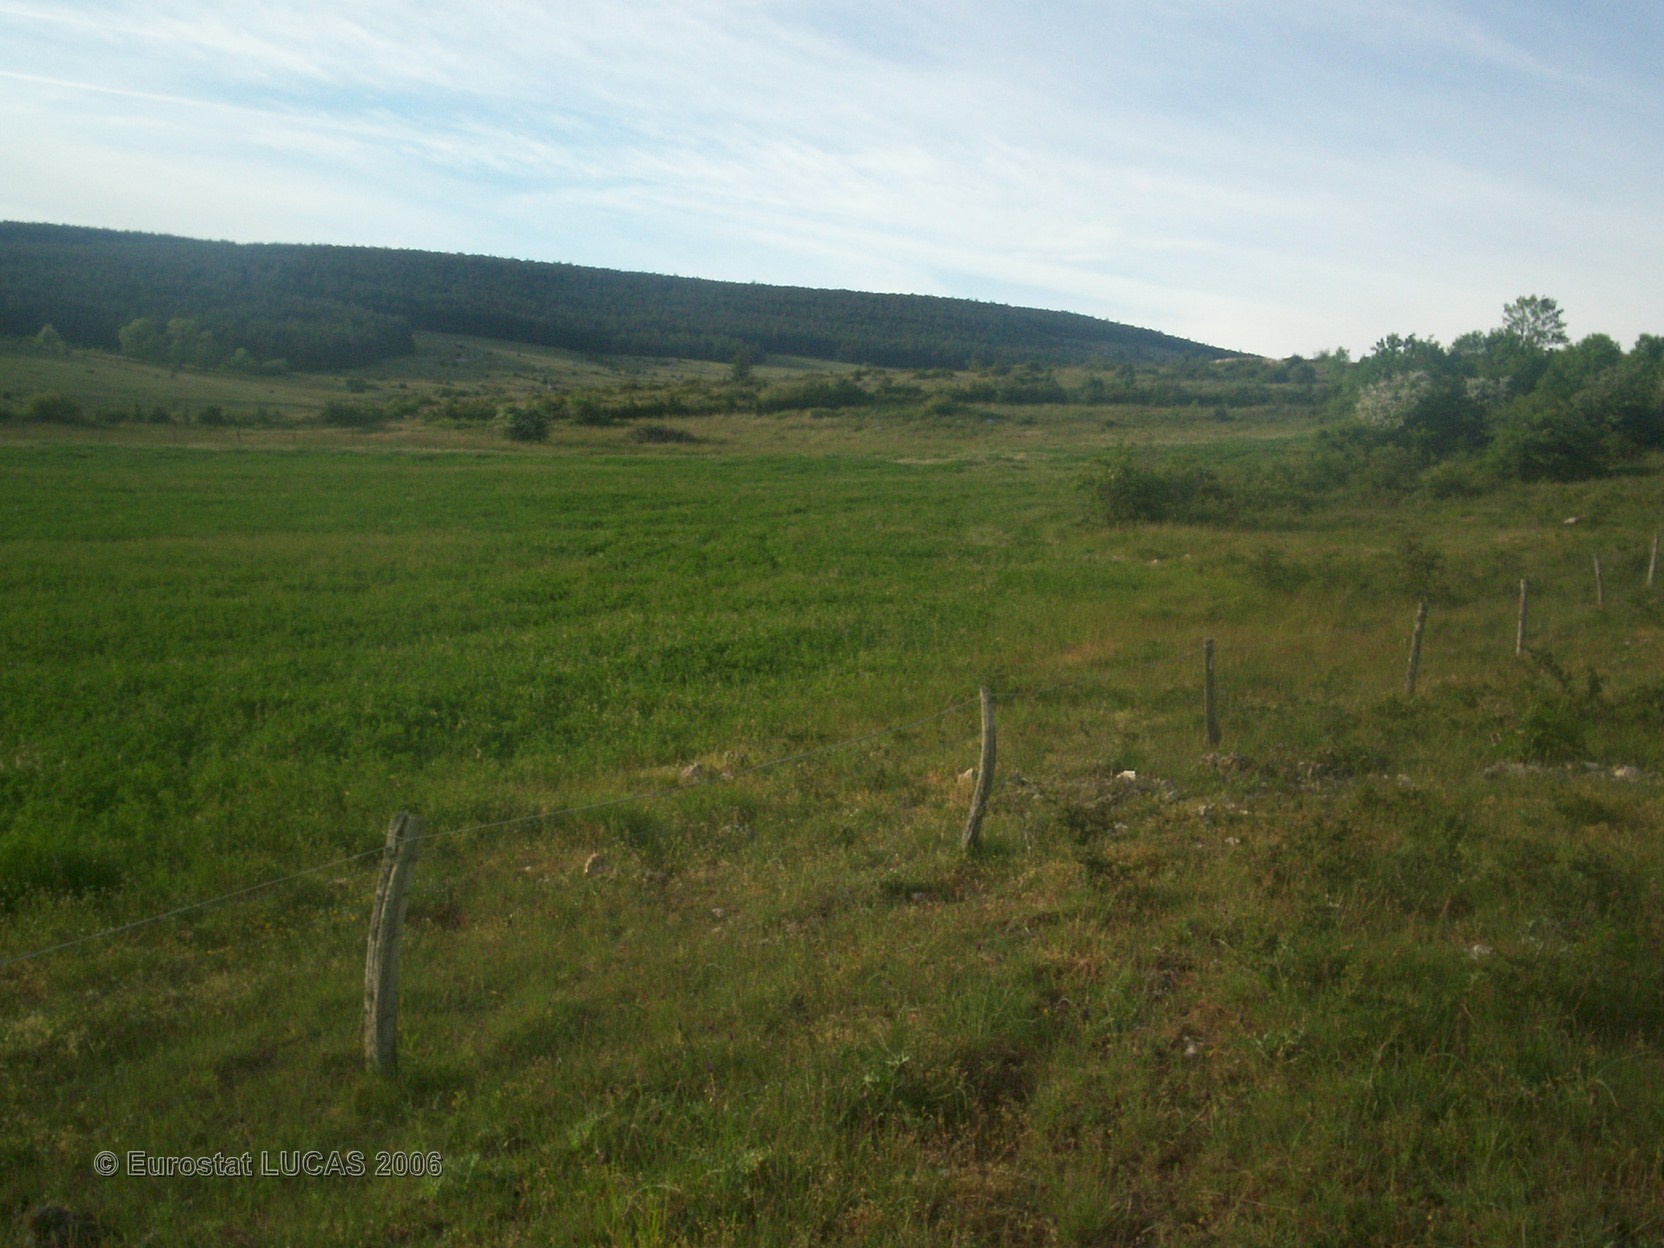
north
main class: Grassland
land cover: Grassland with sparse tree/shrub cover
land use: Agriculture (excluding fallow land and kitchen gardens)
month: June
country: FR
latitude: 44.3782
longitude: 3.4415
